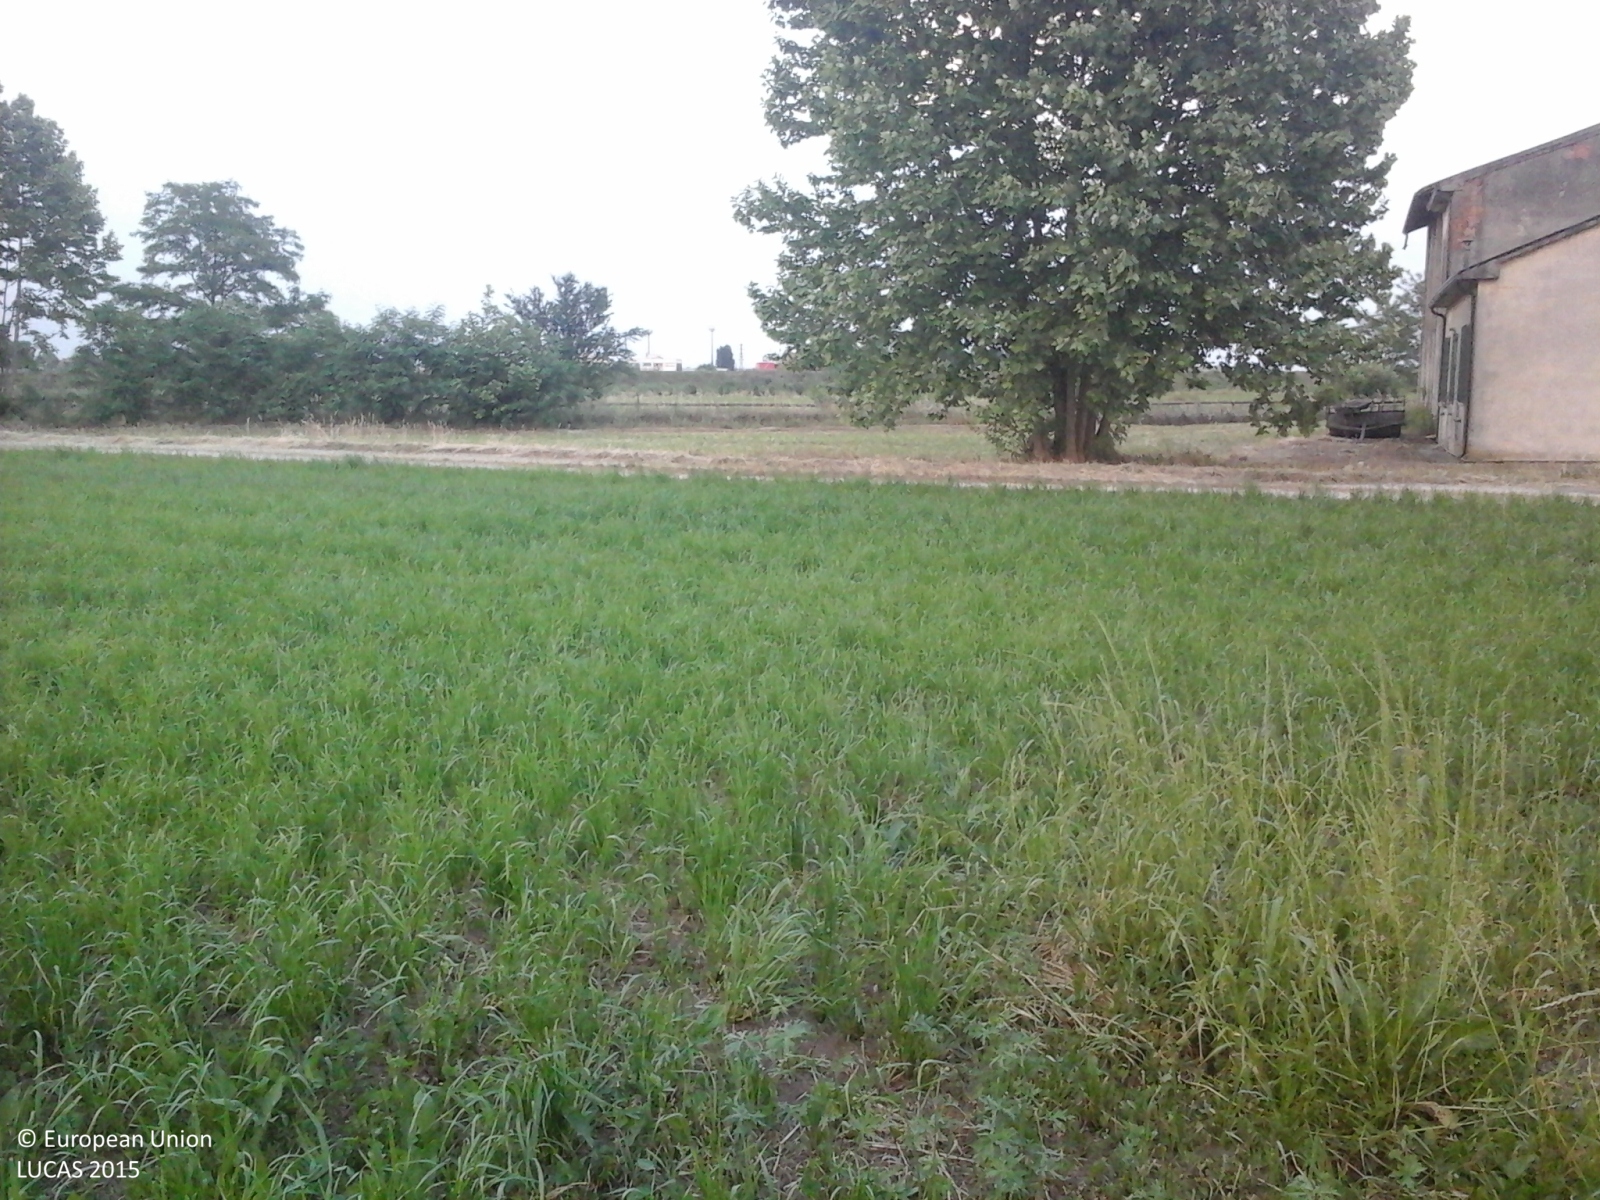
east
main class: Grassland
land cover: Grassland without tree/shrub cover
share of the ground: > 75 %
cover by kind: herbaceous plants 100 %
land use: Agriculture (excluding fallow land and kitchen gardens)
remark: Harvested field
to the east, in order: Grassland without tree/shrub cover; Electric lines; Grassland without tree/shrub cover; Tracks; Ditches and canals; Single bushes/trees; Grassland without tree/shrub cover; Ditches and canals; Grass margins; Paved roads, cycling and walking lanes; Fences; Grass margins; Ditches and canals; Grass margins; Grassland without tree/shrub cover; Broadleaved woodland; Grassland without tree/shrub cover
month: May
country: IT
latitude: 45.2133
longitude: 10.7499
